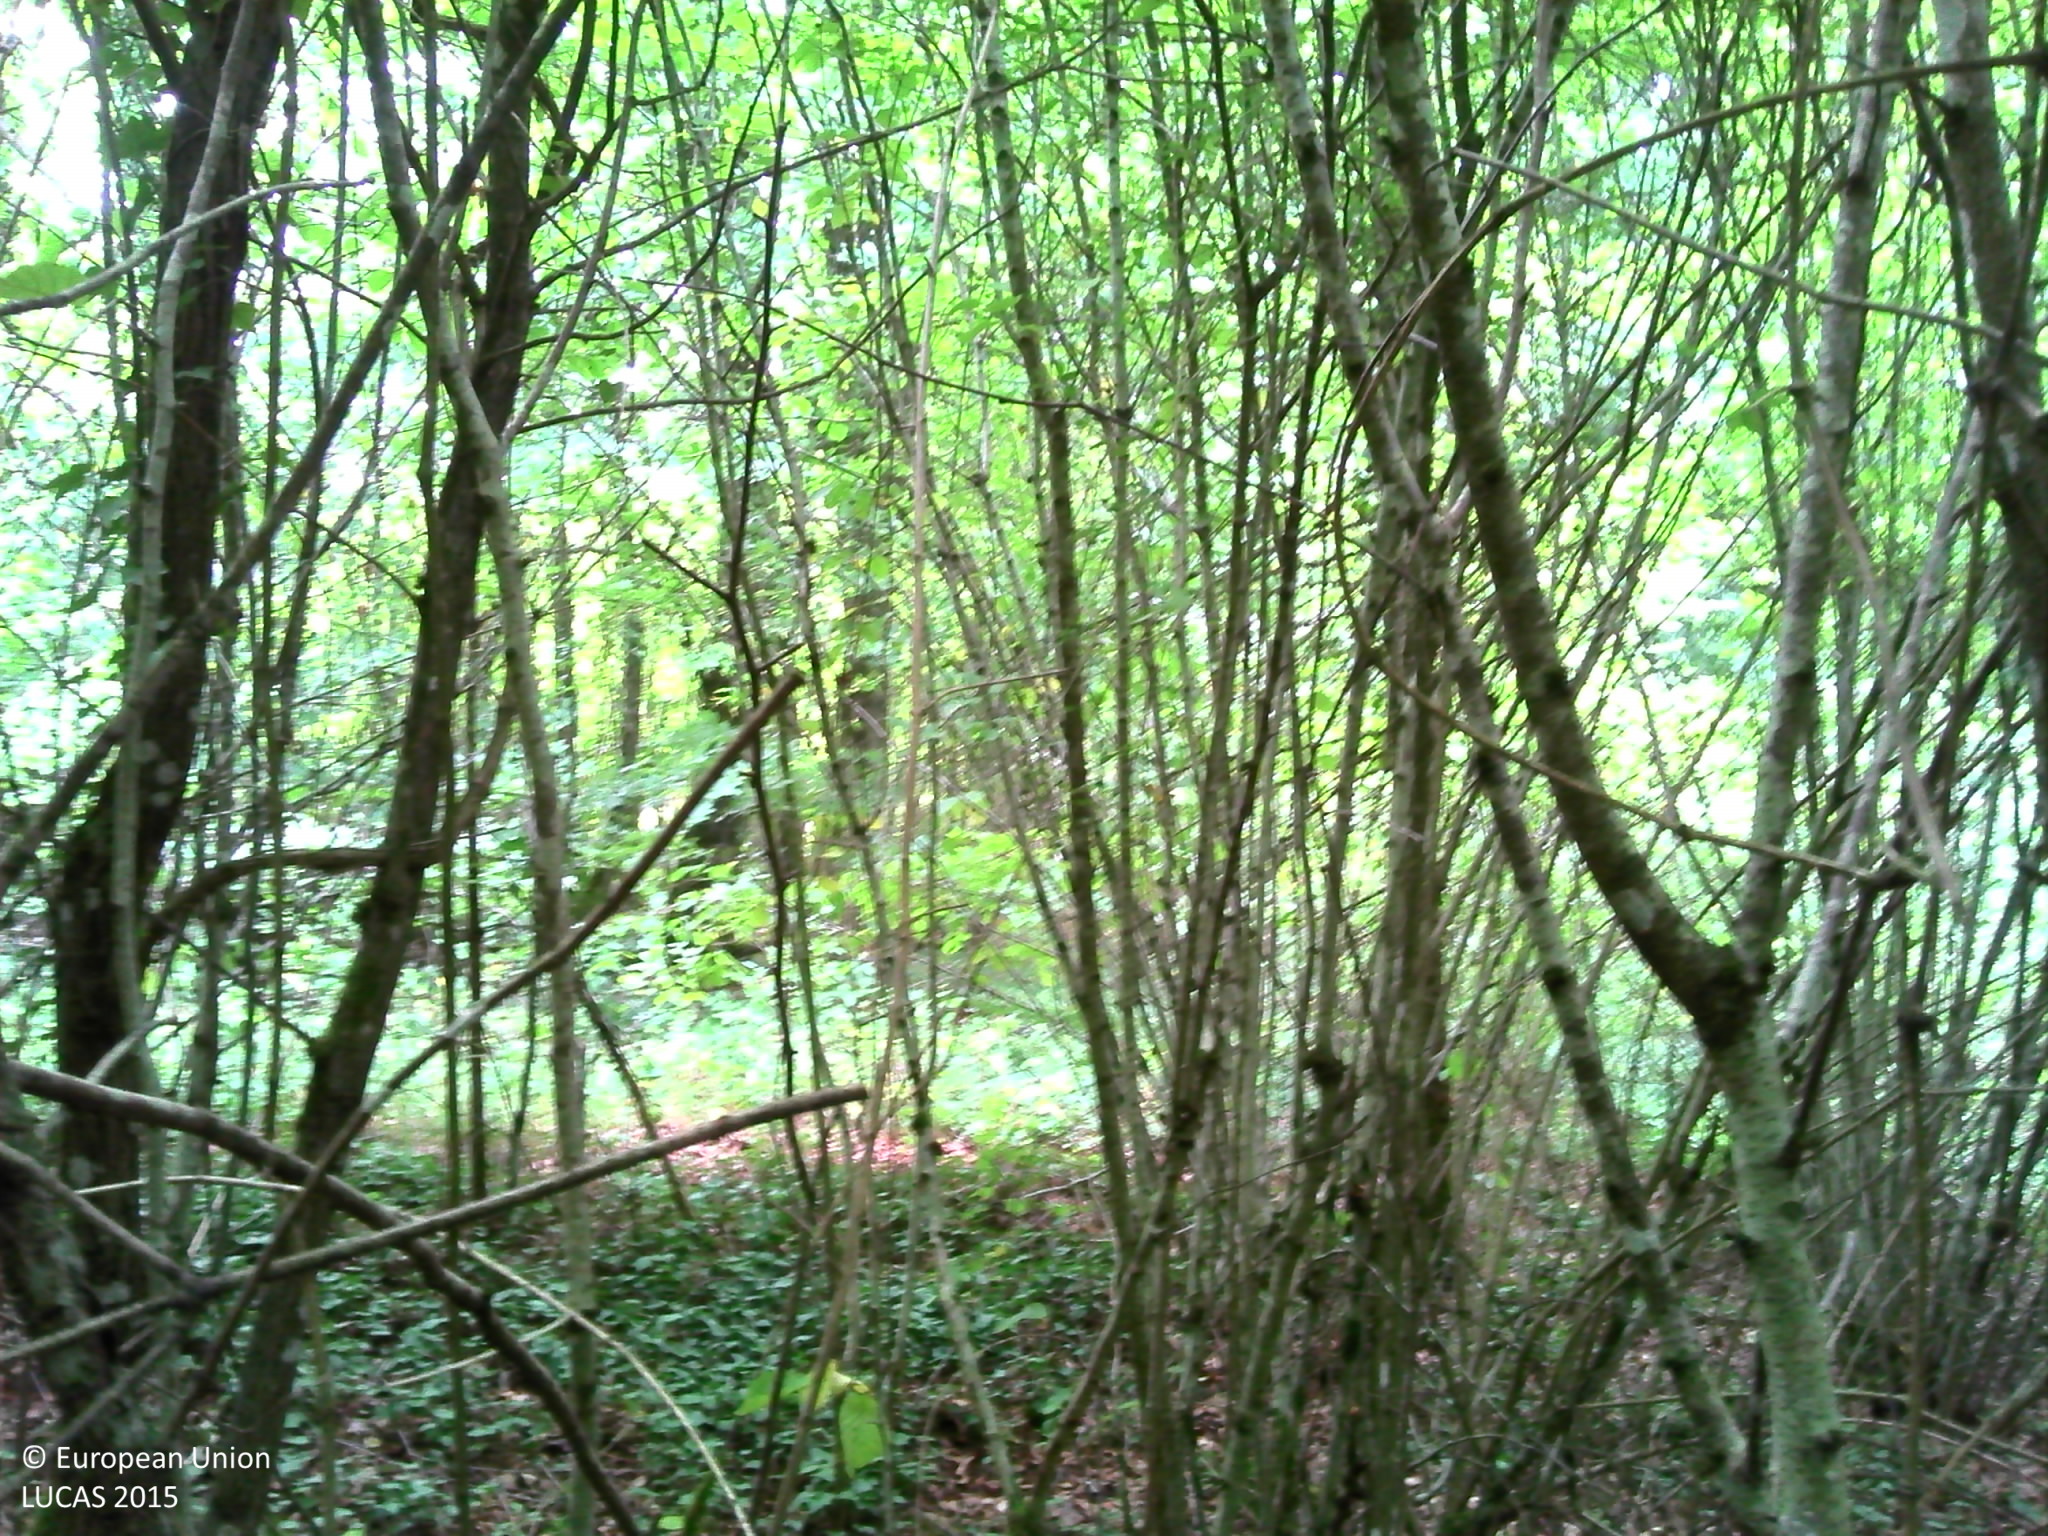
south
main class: Woodland
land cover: Other mixed woodland
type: exotic forest
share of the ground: > 75 %
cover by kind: coniferous forest trees 50 %, broadleaved forest trees 40 %, herbaceous plants 5 %, lichens and mosses 5 %
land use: Forestry
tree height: > 5 m
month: August
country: FR
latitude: 47.6919
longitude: 4.9232
